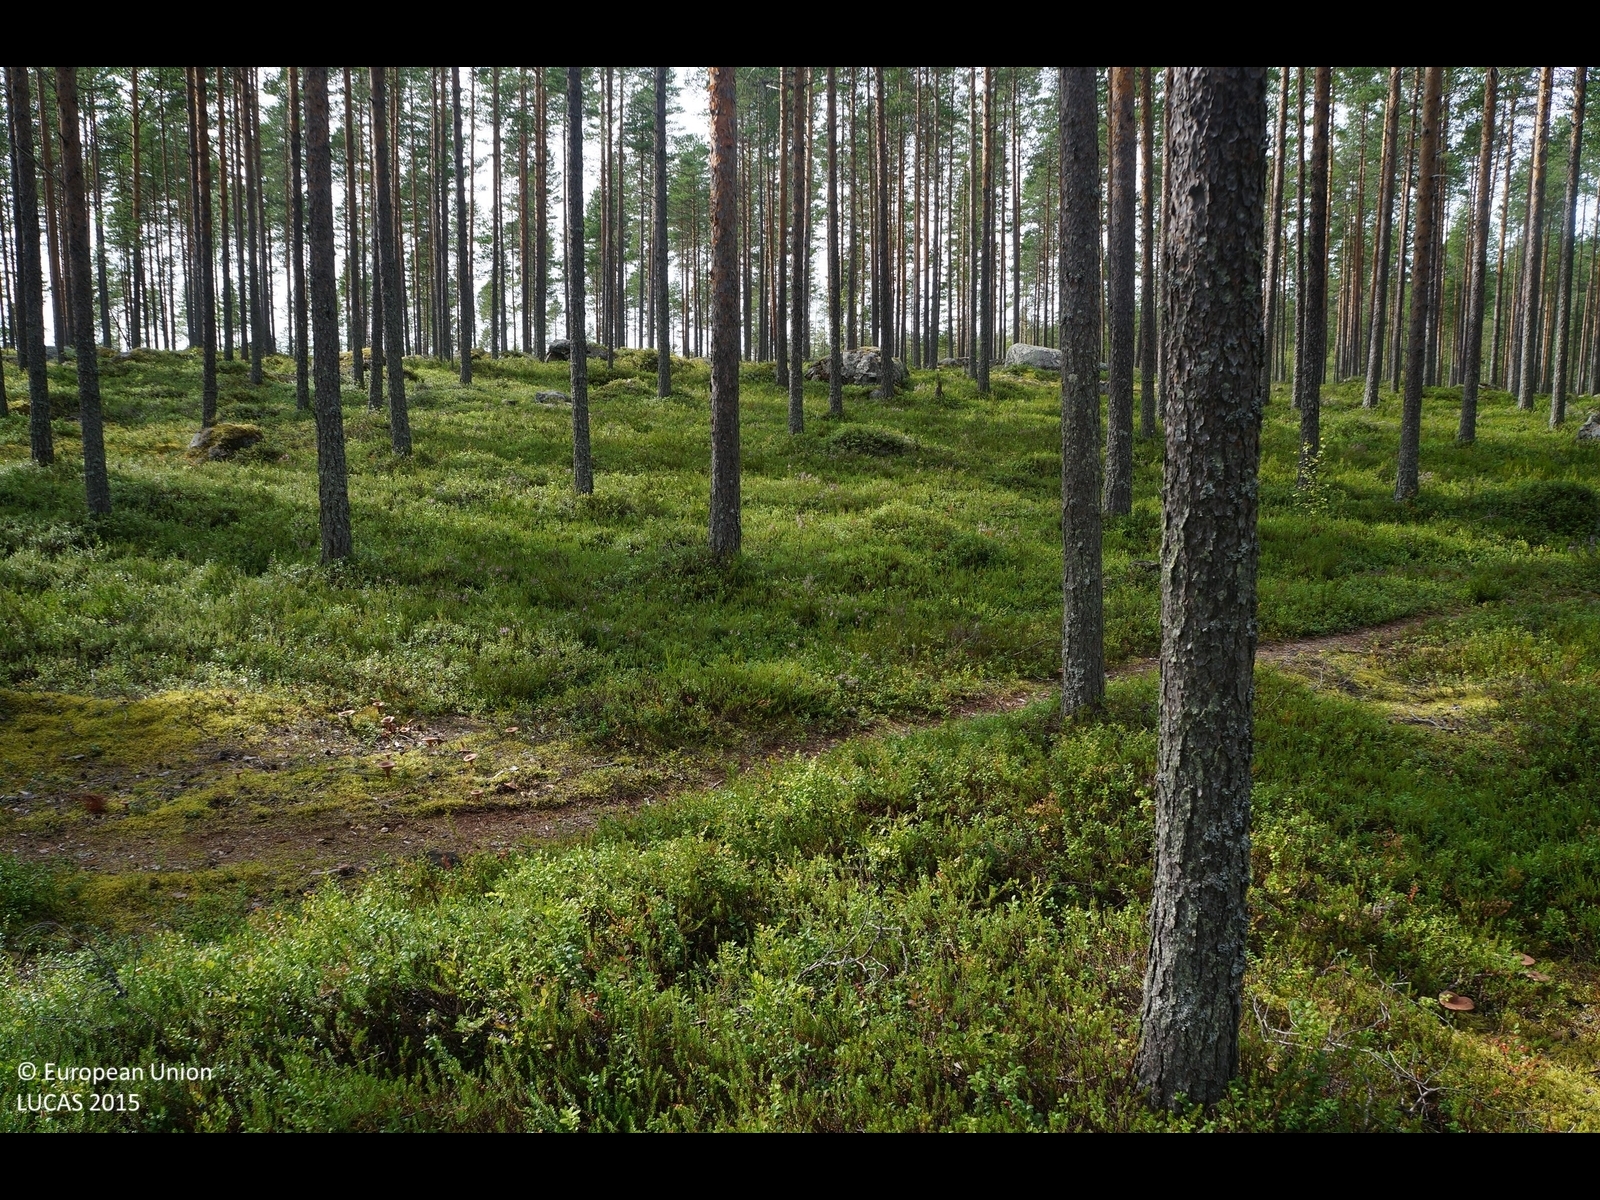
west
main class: Woodland
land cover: Pine dominated coniferous woodland
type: boreal forest
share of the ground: 50 - 75 %
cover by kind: coniferous forest trees 50 %, shrubs 45 %, lichens and mosses 5 %
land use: Forestry
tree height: > 5 m
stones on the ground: < 10 %
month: August
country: FI
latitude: 64.6199
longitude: 24.8155
